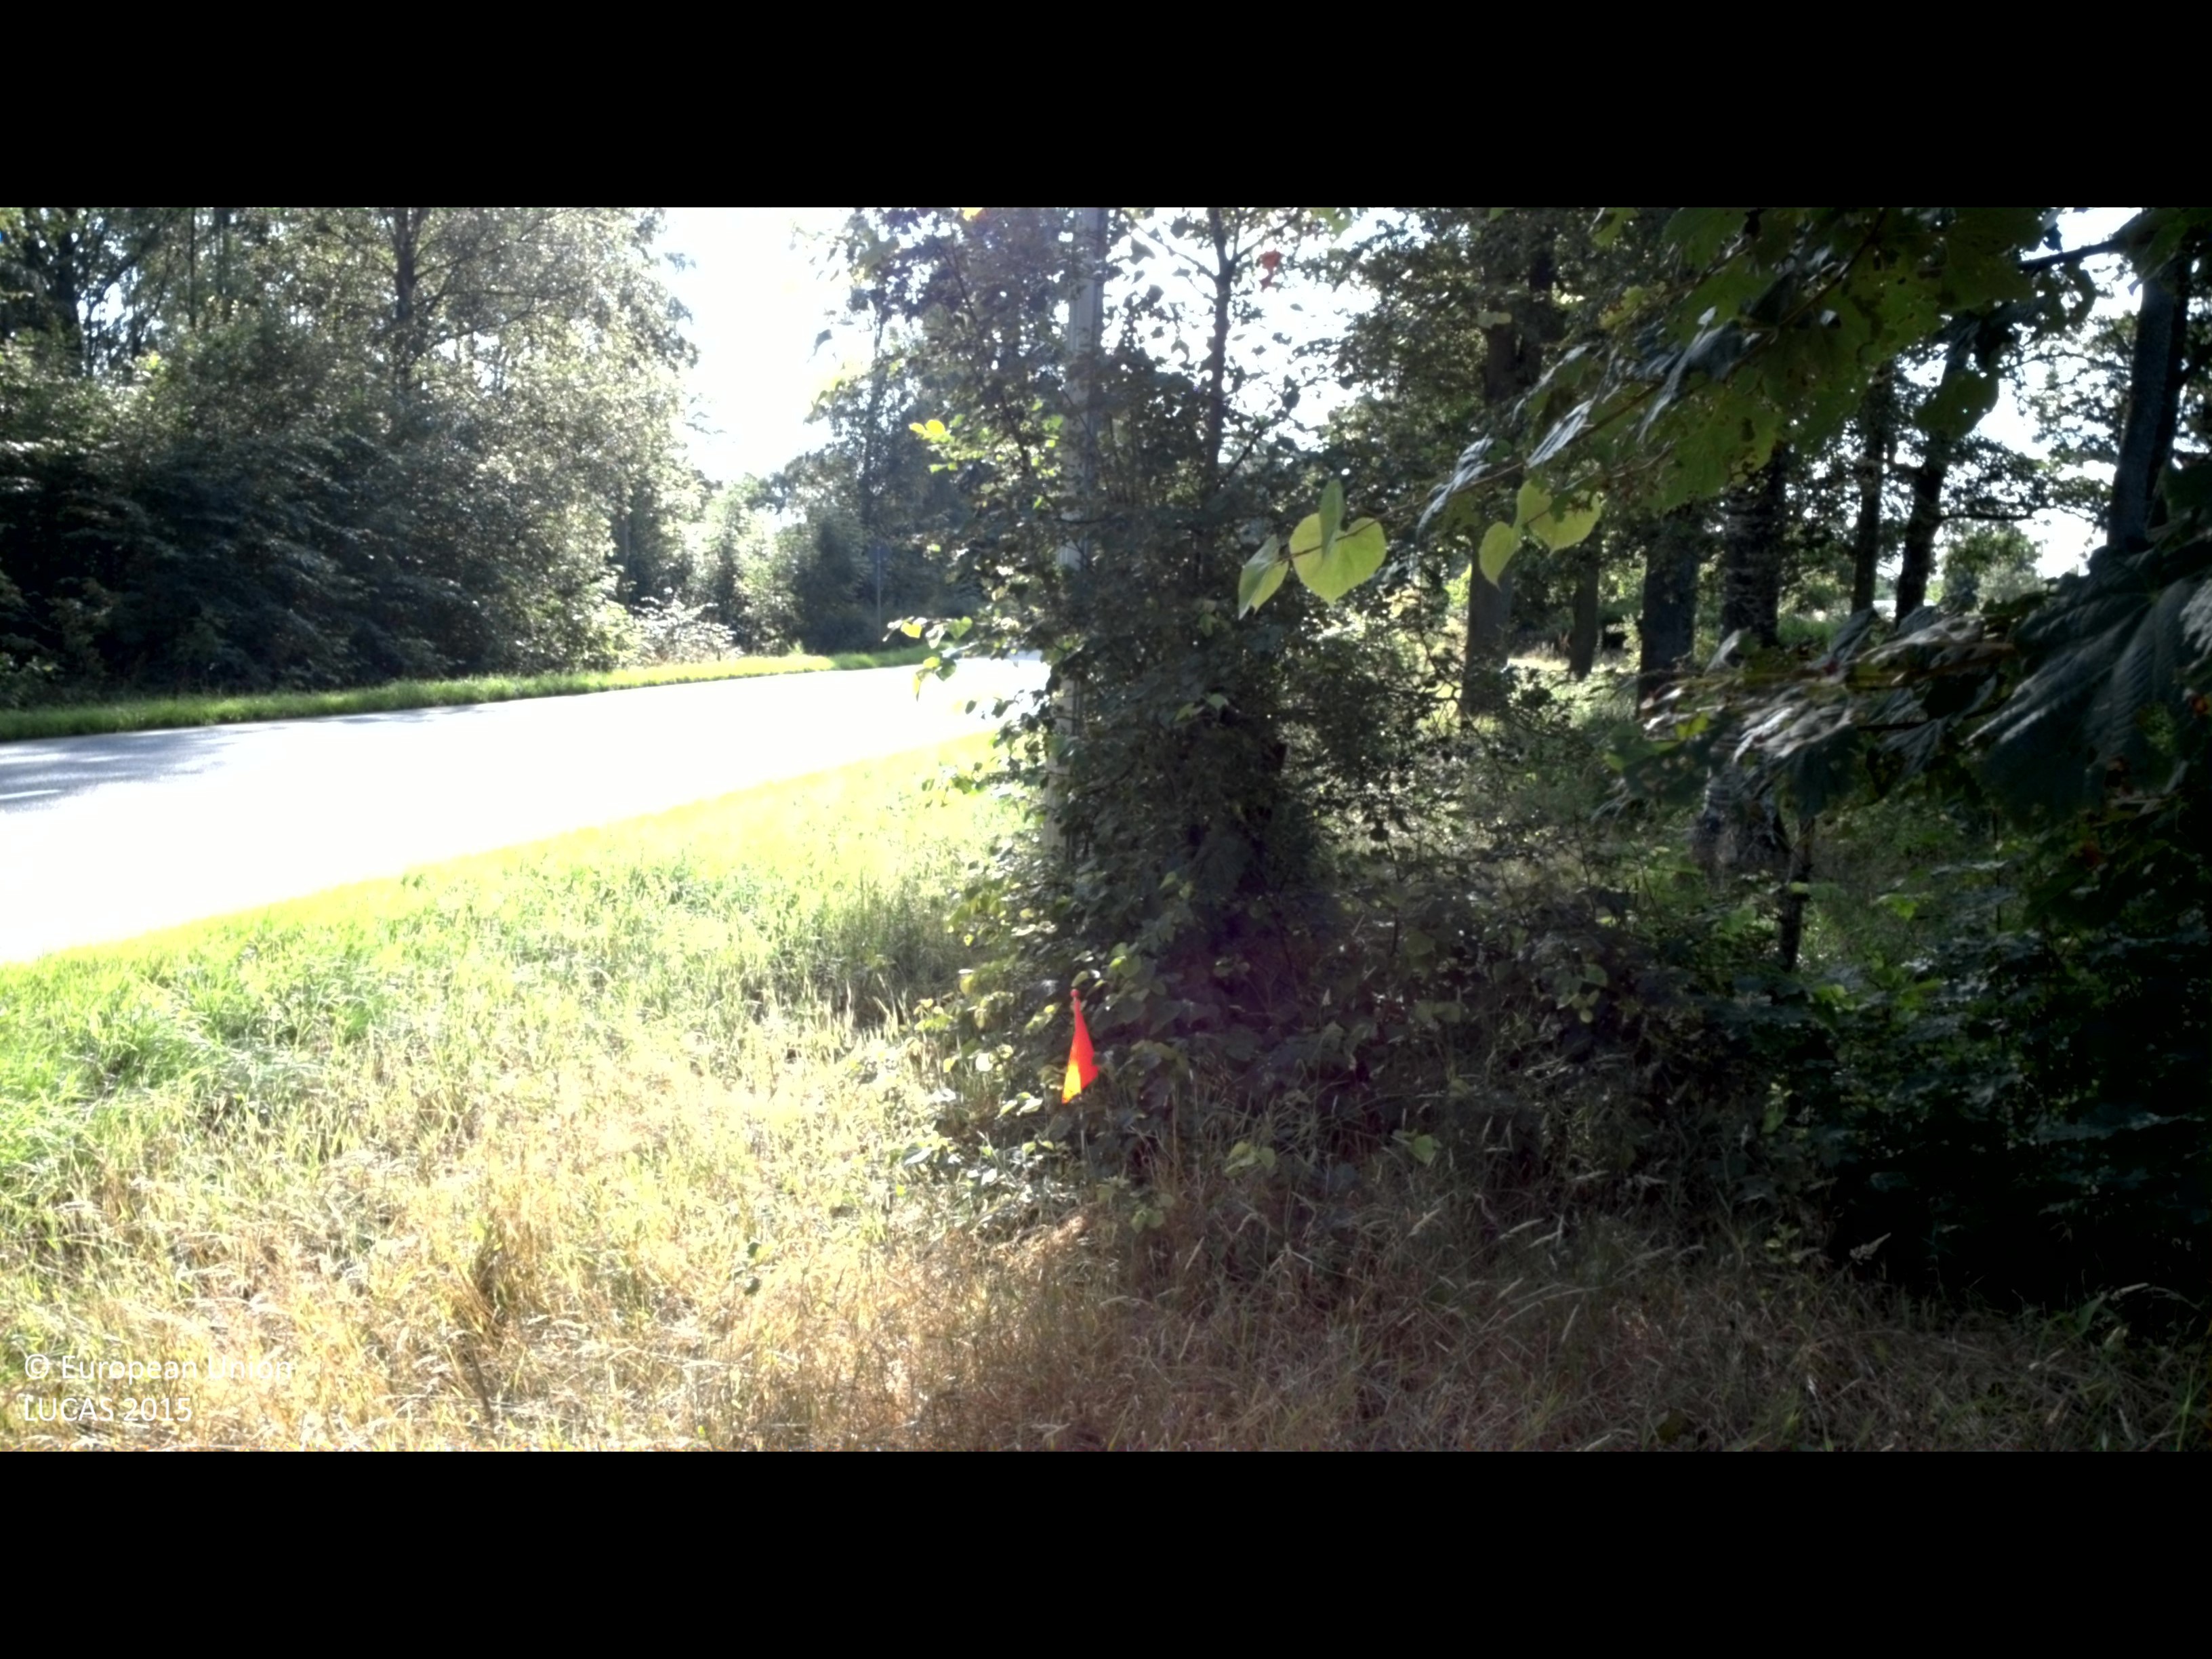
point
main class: Woodland
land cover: Broadleaved woodland
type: boreal forest
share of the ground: 50 - 75 %
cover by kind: broadleaved forest trees 60 %, herbaceous plants 30 %, shrubs 10 %
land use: Residential
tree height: > 5 m
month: August
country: SE
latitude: 56.8221
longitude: 14.1748
